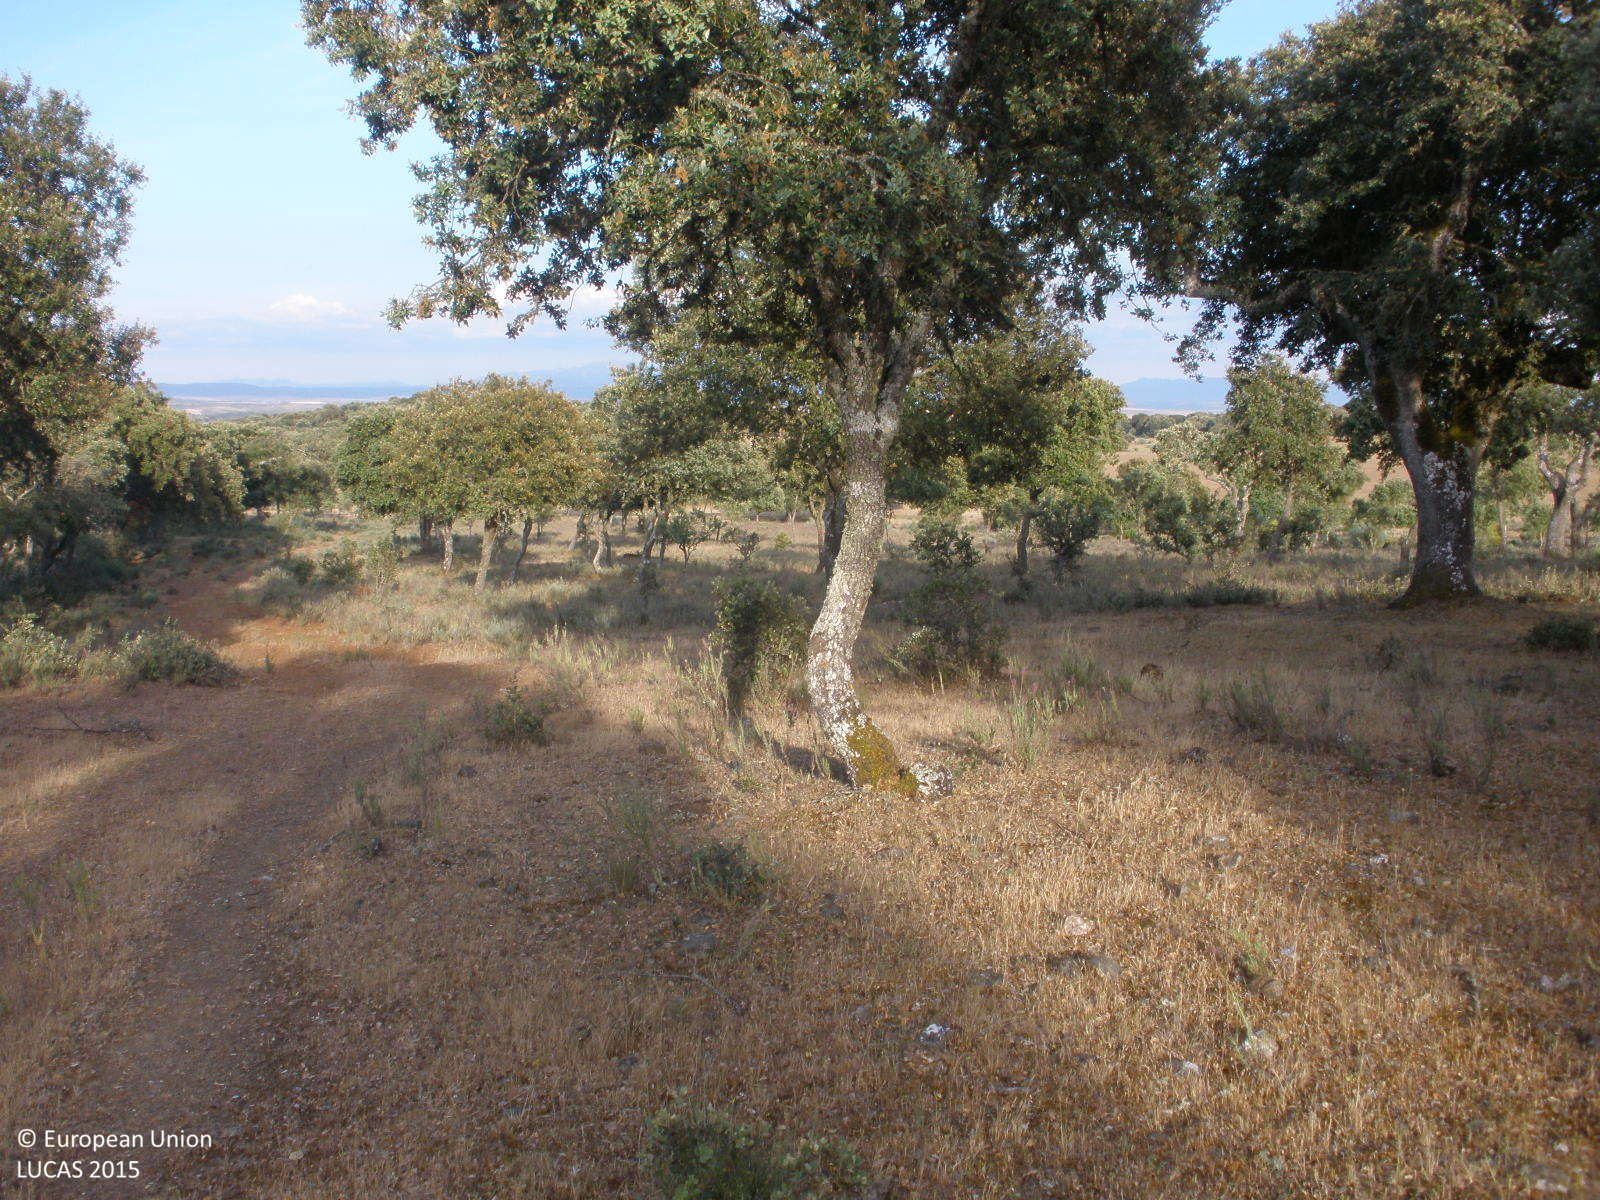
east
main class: Woodland
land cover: Broadleaved woodland
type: broadleaved evergreen forest
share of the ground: 25 - 50 %
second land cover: Grassland without tree/shrub cover
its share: > 75 %
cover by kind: herbaceous plants 60 %, broadleaved forest trees 40 %
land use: Forestry
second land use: Agriculture (excluding fallow land and kitchen gardens)
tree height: > 5 m
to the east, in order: Broadleaved woodland; Grassland without tree/shrub cover; Fences; Dry stone walls; Broadleaved woodland; Grassland without tree/shrub cover; Broadleaved woodland
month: June
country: ES
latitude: 40.6605
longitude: -6.7374
